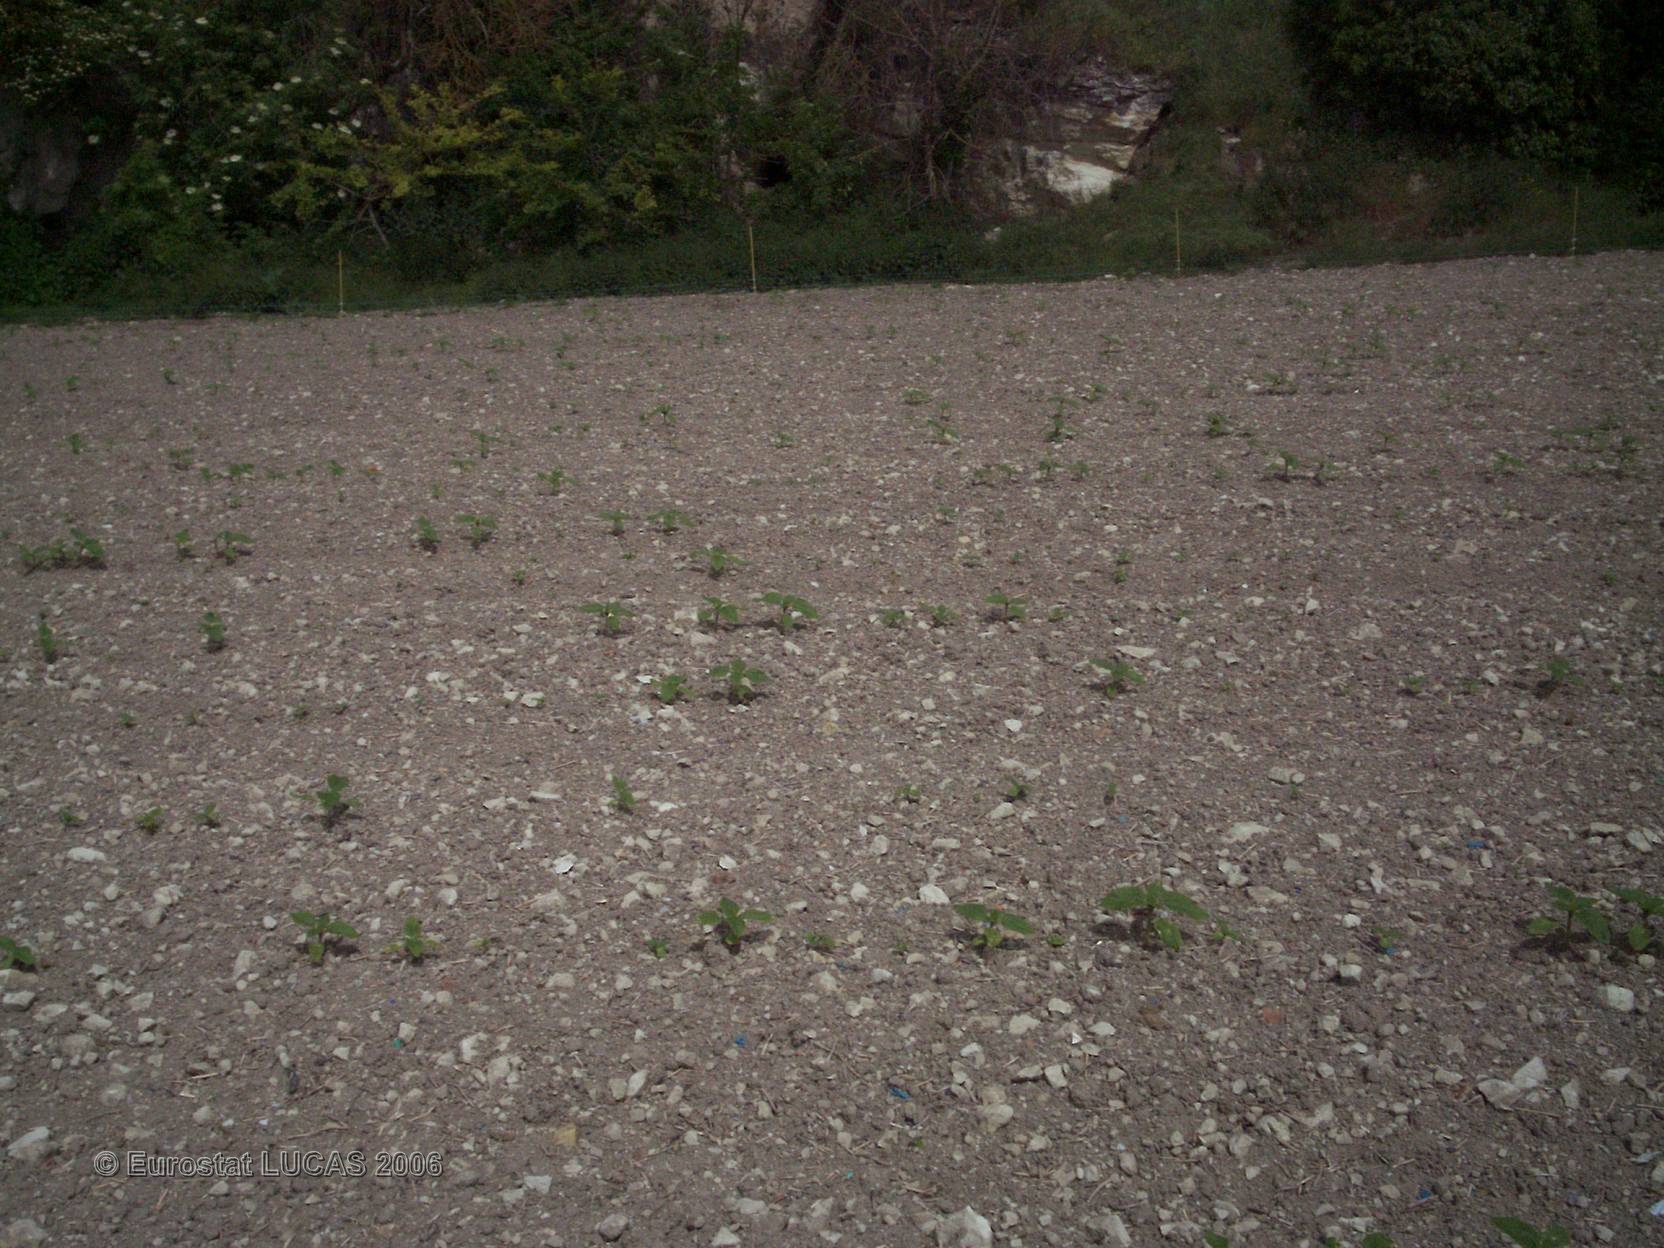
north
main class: Cropland
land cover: Sunflower
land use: Agriculture (excluding fallow land and kitchen gardens)
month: May
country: FR
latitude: 46.8272
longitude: 0.4241
